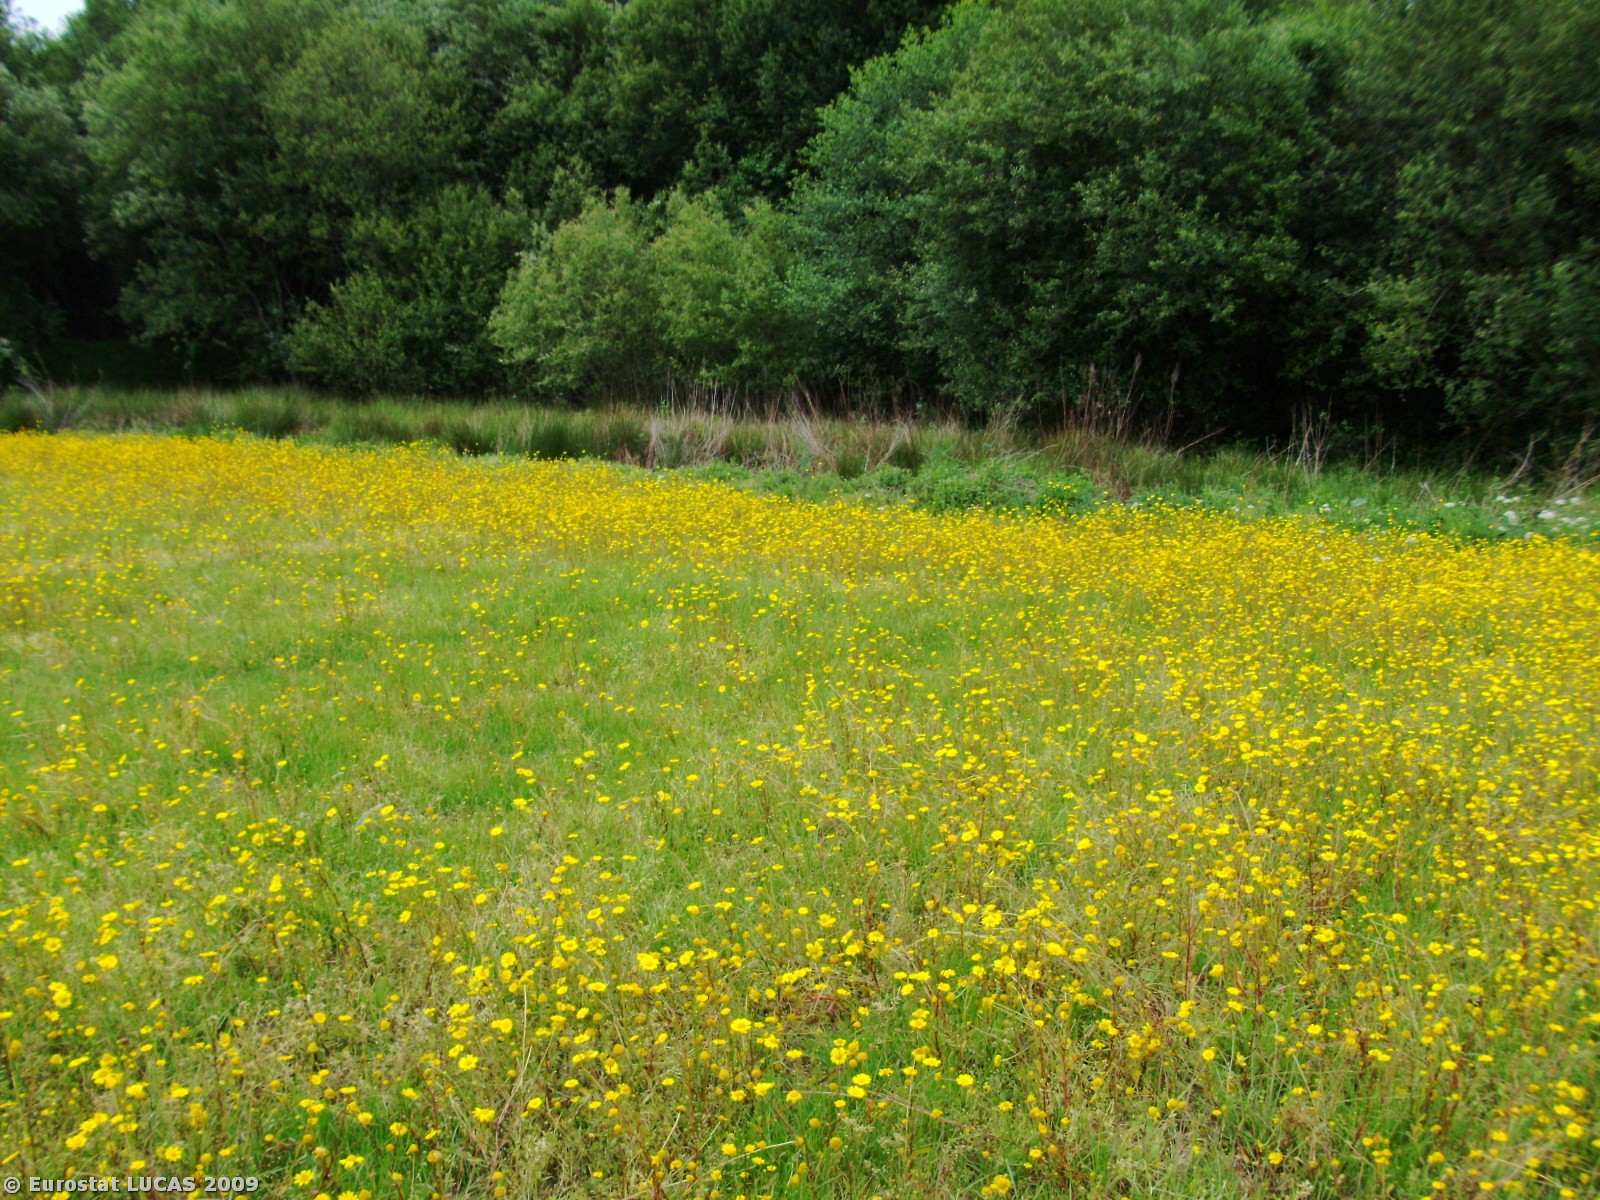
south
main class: Grassland
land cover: Spontaneously vegetated surfaces
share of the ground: > 75 %
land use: Fallow land
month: May
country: PT
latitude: 40.9855
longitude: -8.5105
